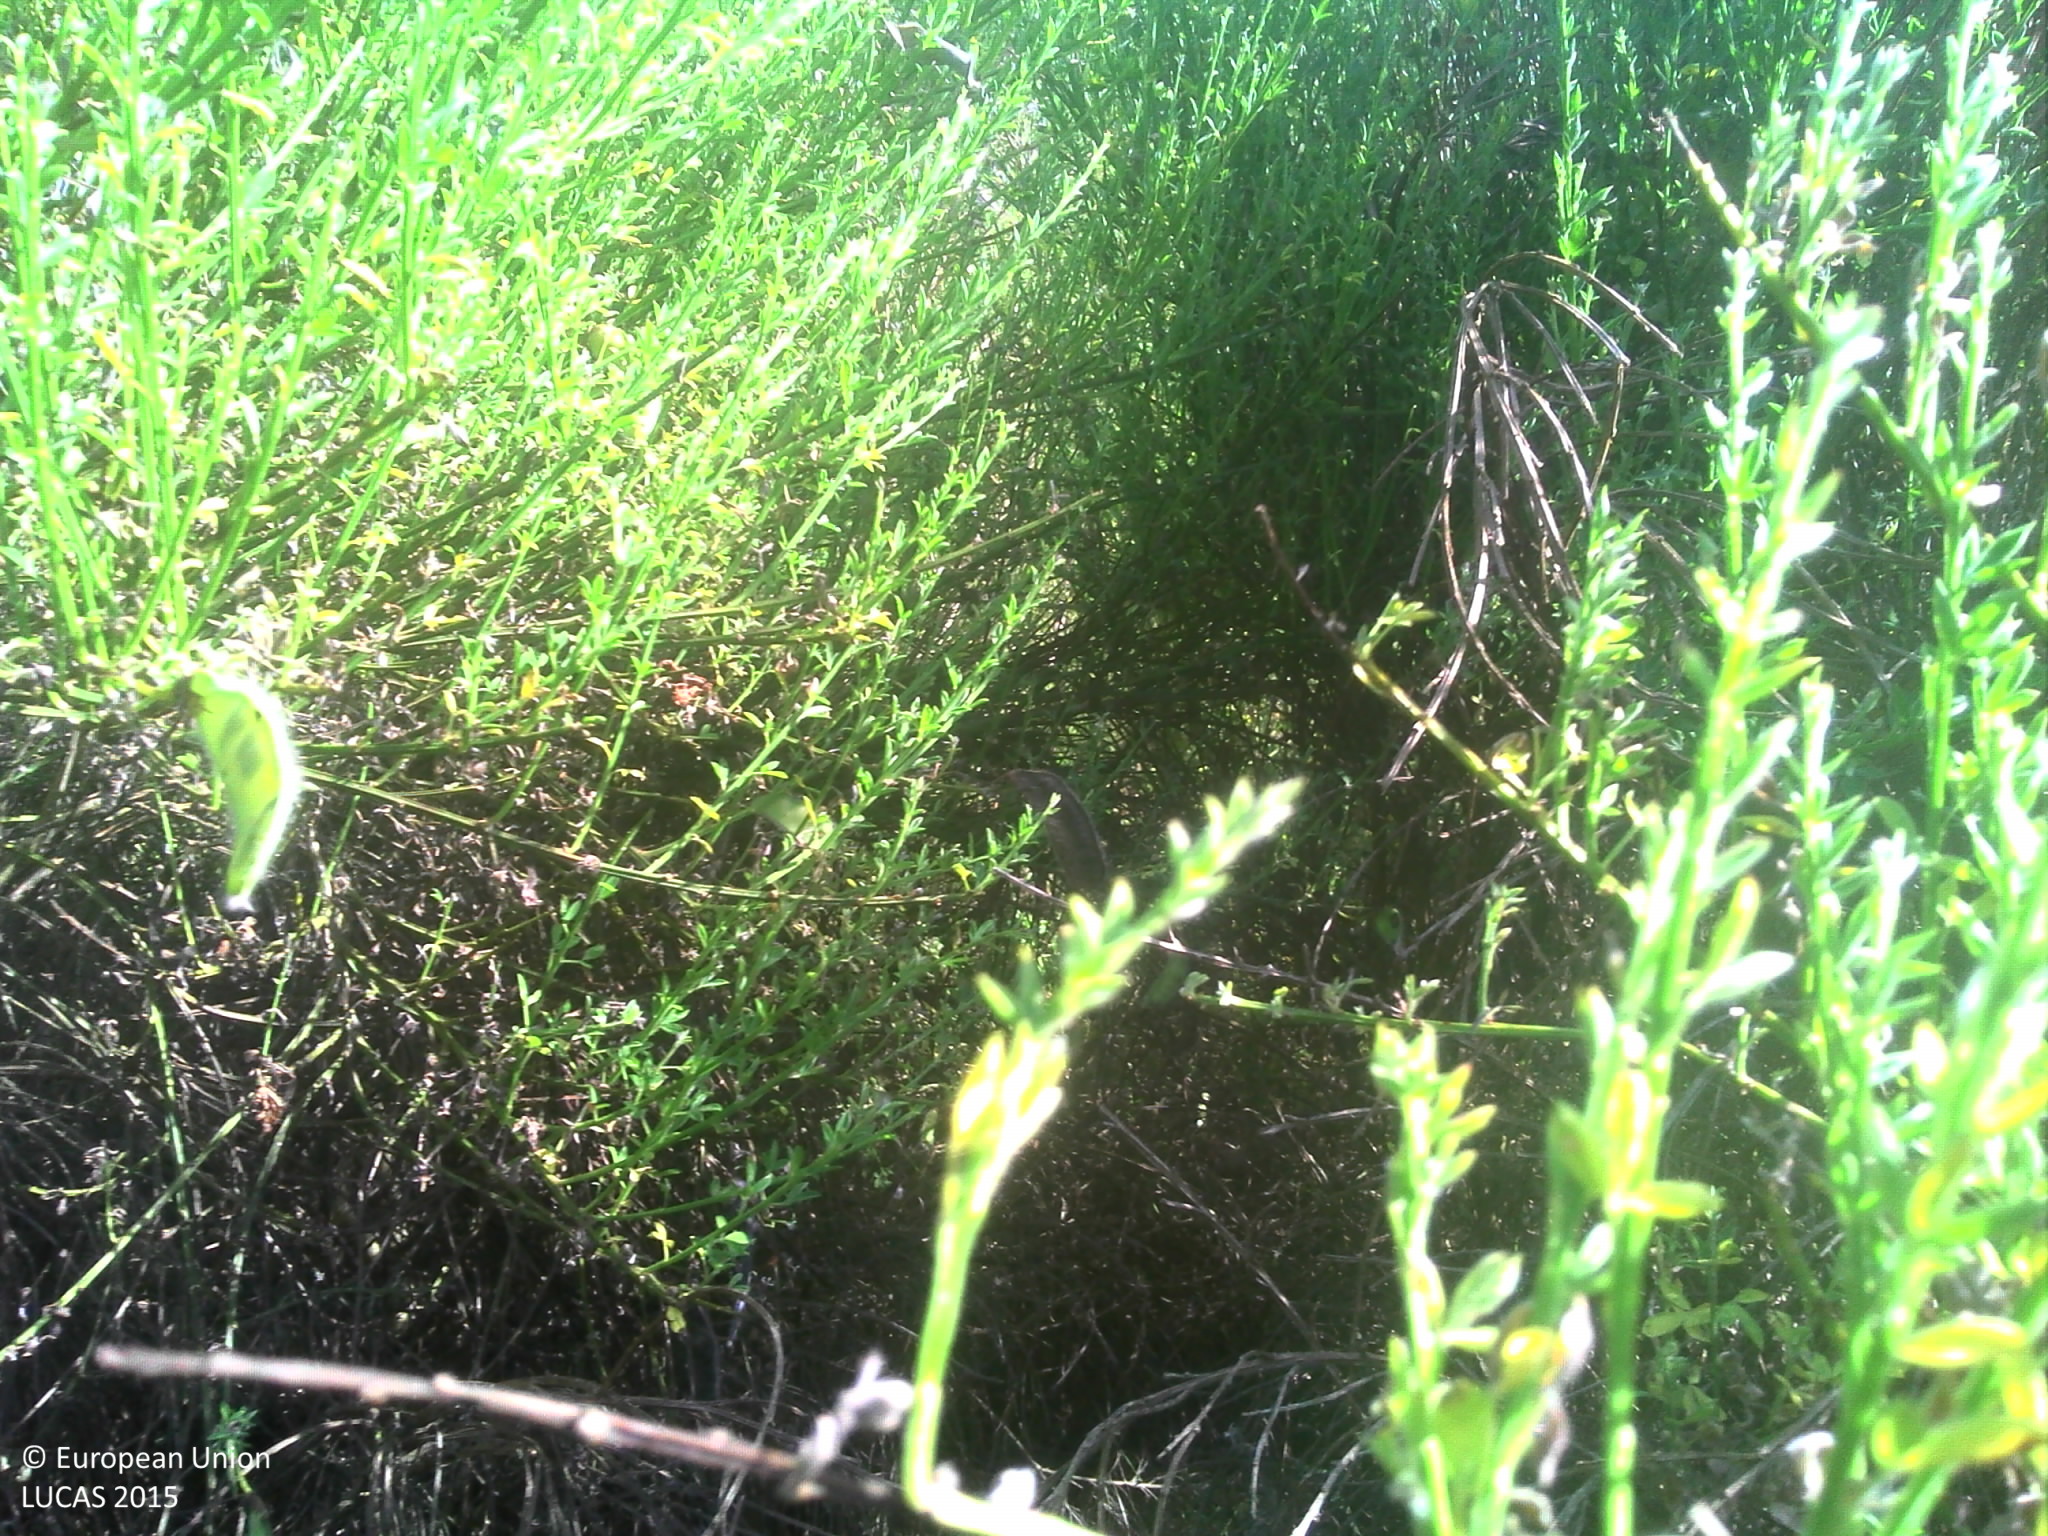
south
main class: Woodland
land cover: Pine dominated coniferous woodland
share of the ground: > 75 %
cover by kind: coniferous forest trees 50 %, lichens and mosses 20 %, unconsolidated bare surface 20 %, herbaceous plants 10 %
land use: Forestry
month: June
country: FR
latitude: 47.2806
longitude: 1.5127
